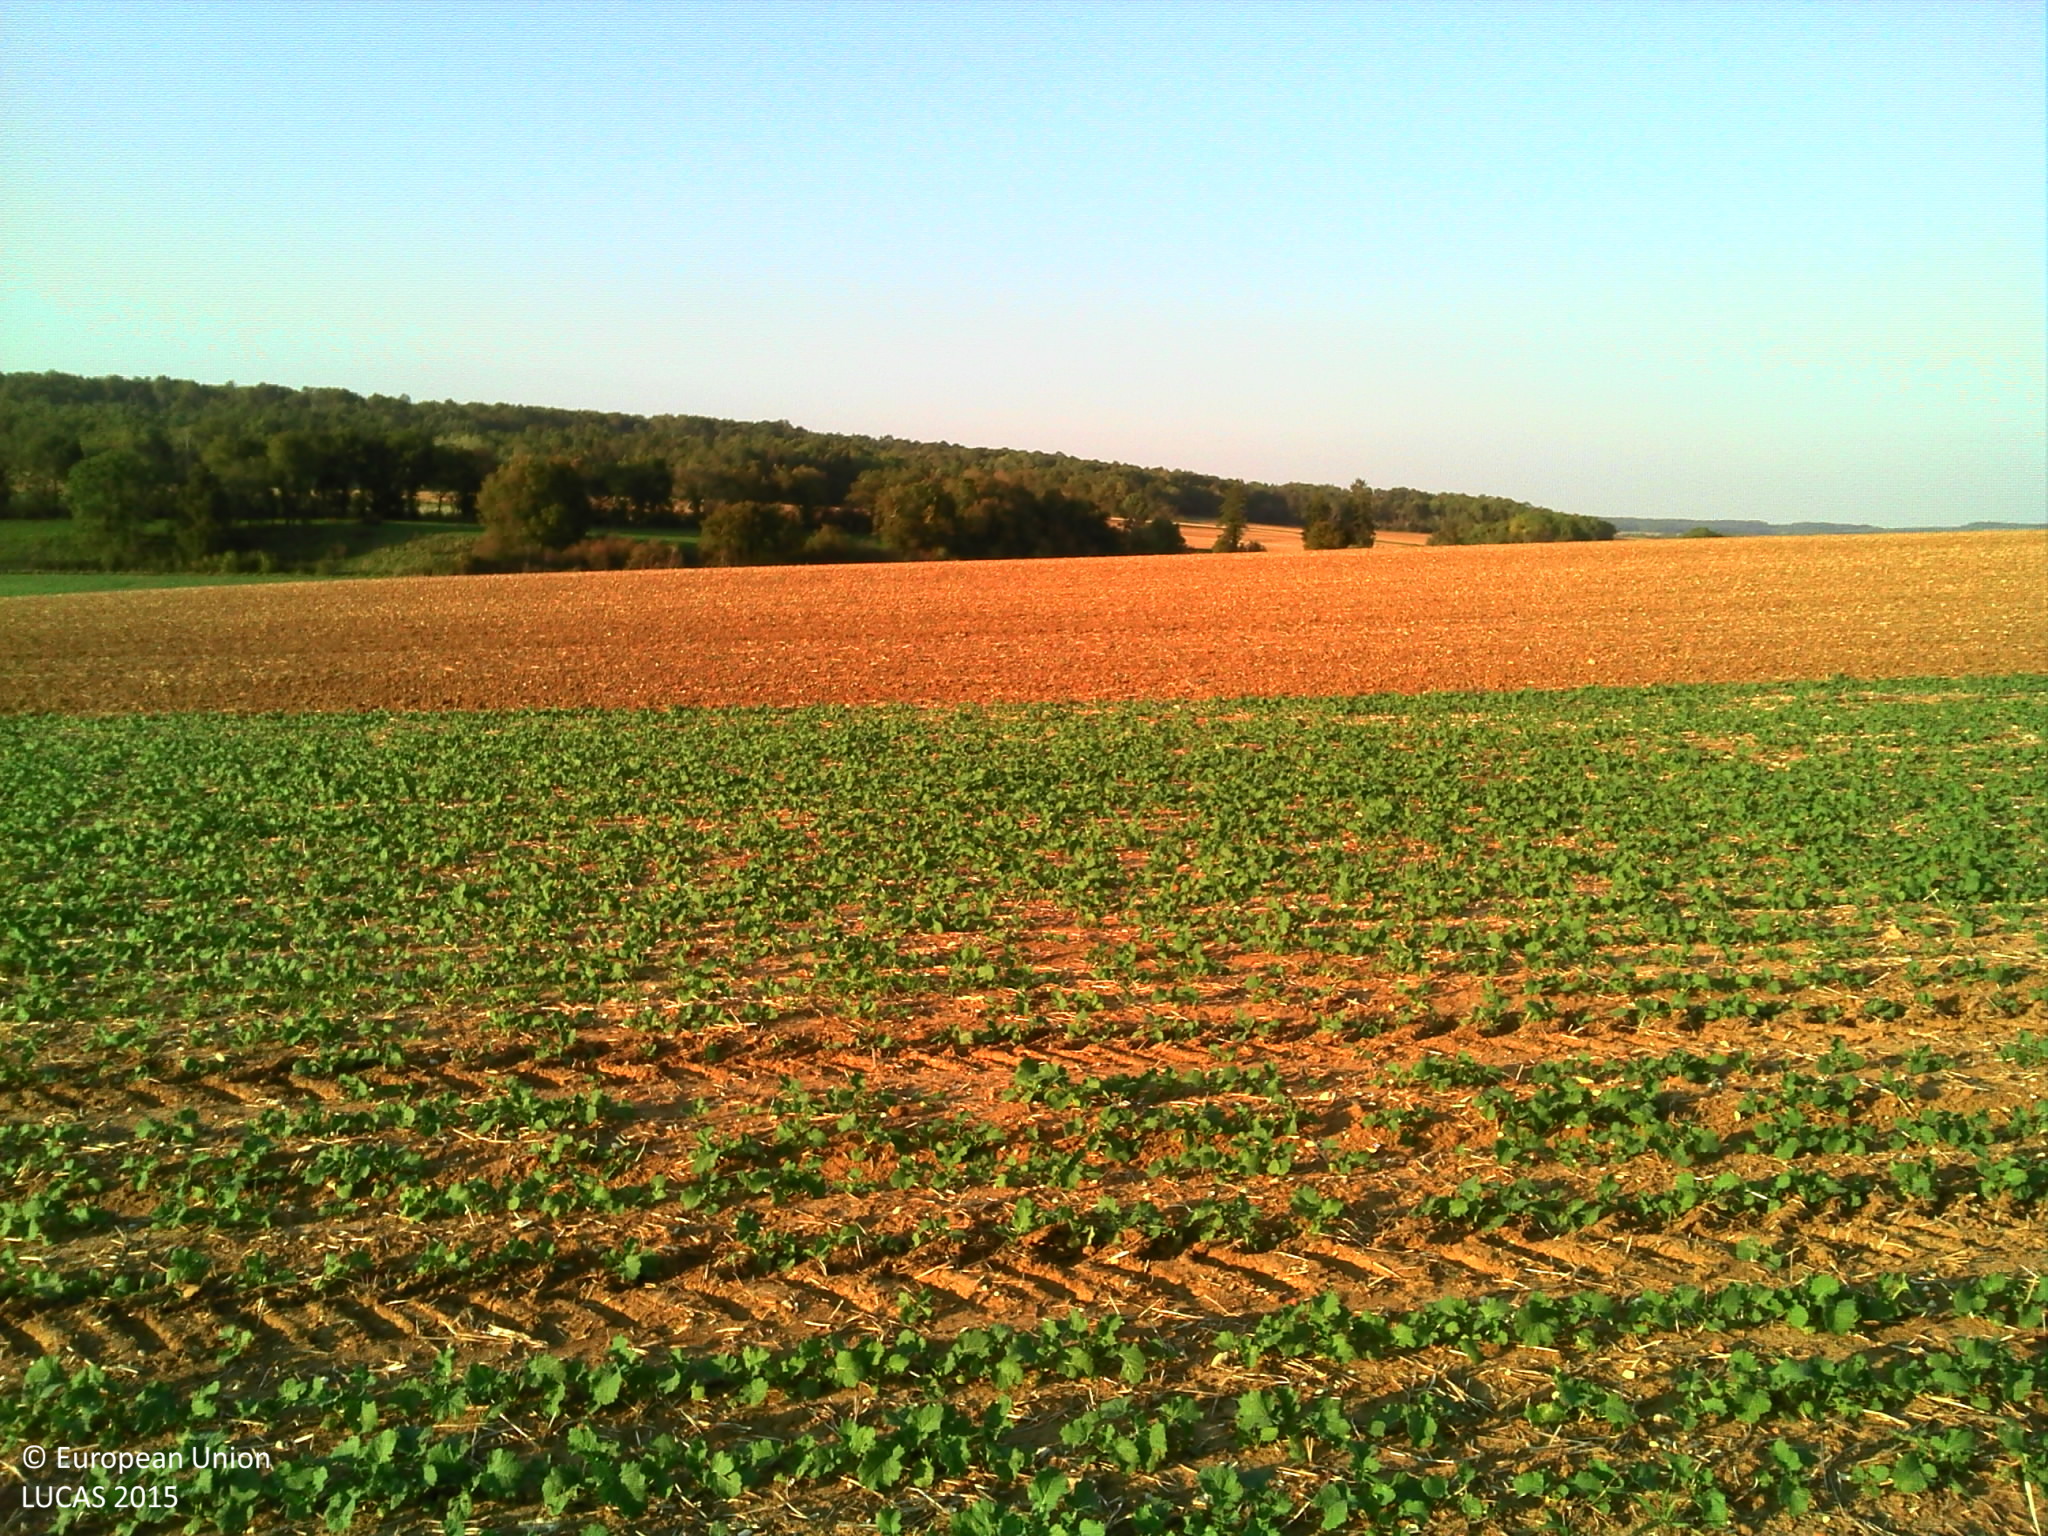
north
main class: Cropland
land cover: Rape and turnip rape
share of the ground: 25 - 50 %
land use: Agriculture (excluding fallow land and kitchen gardens)
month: October
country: FR
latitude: 48.1116
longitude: 4.2889
